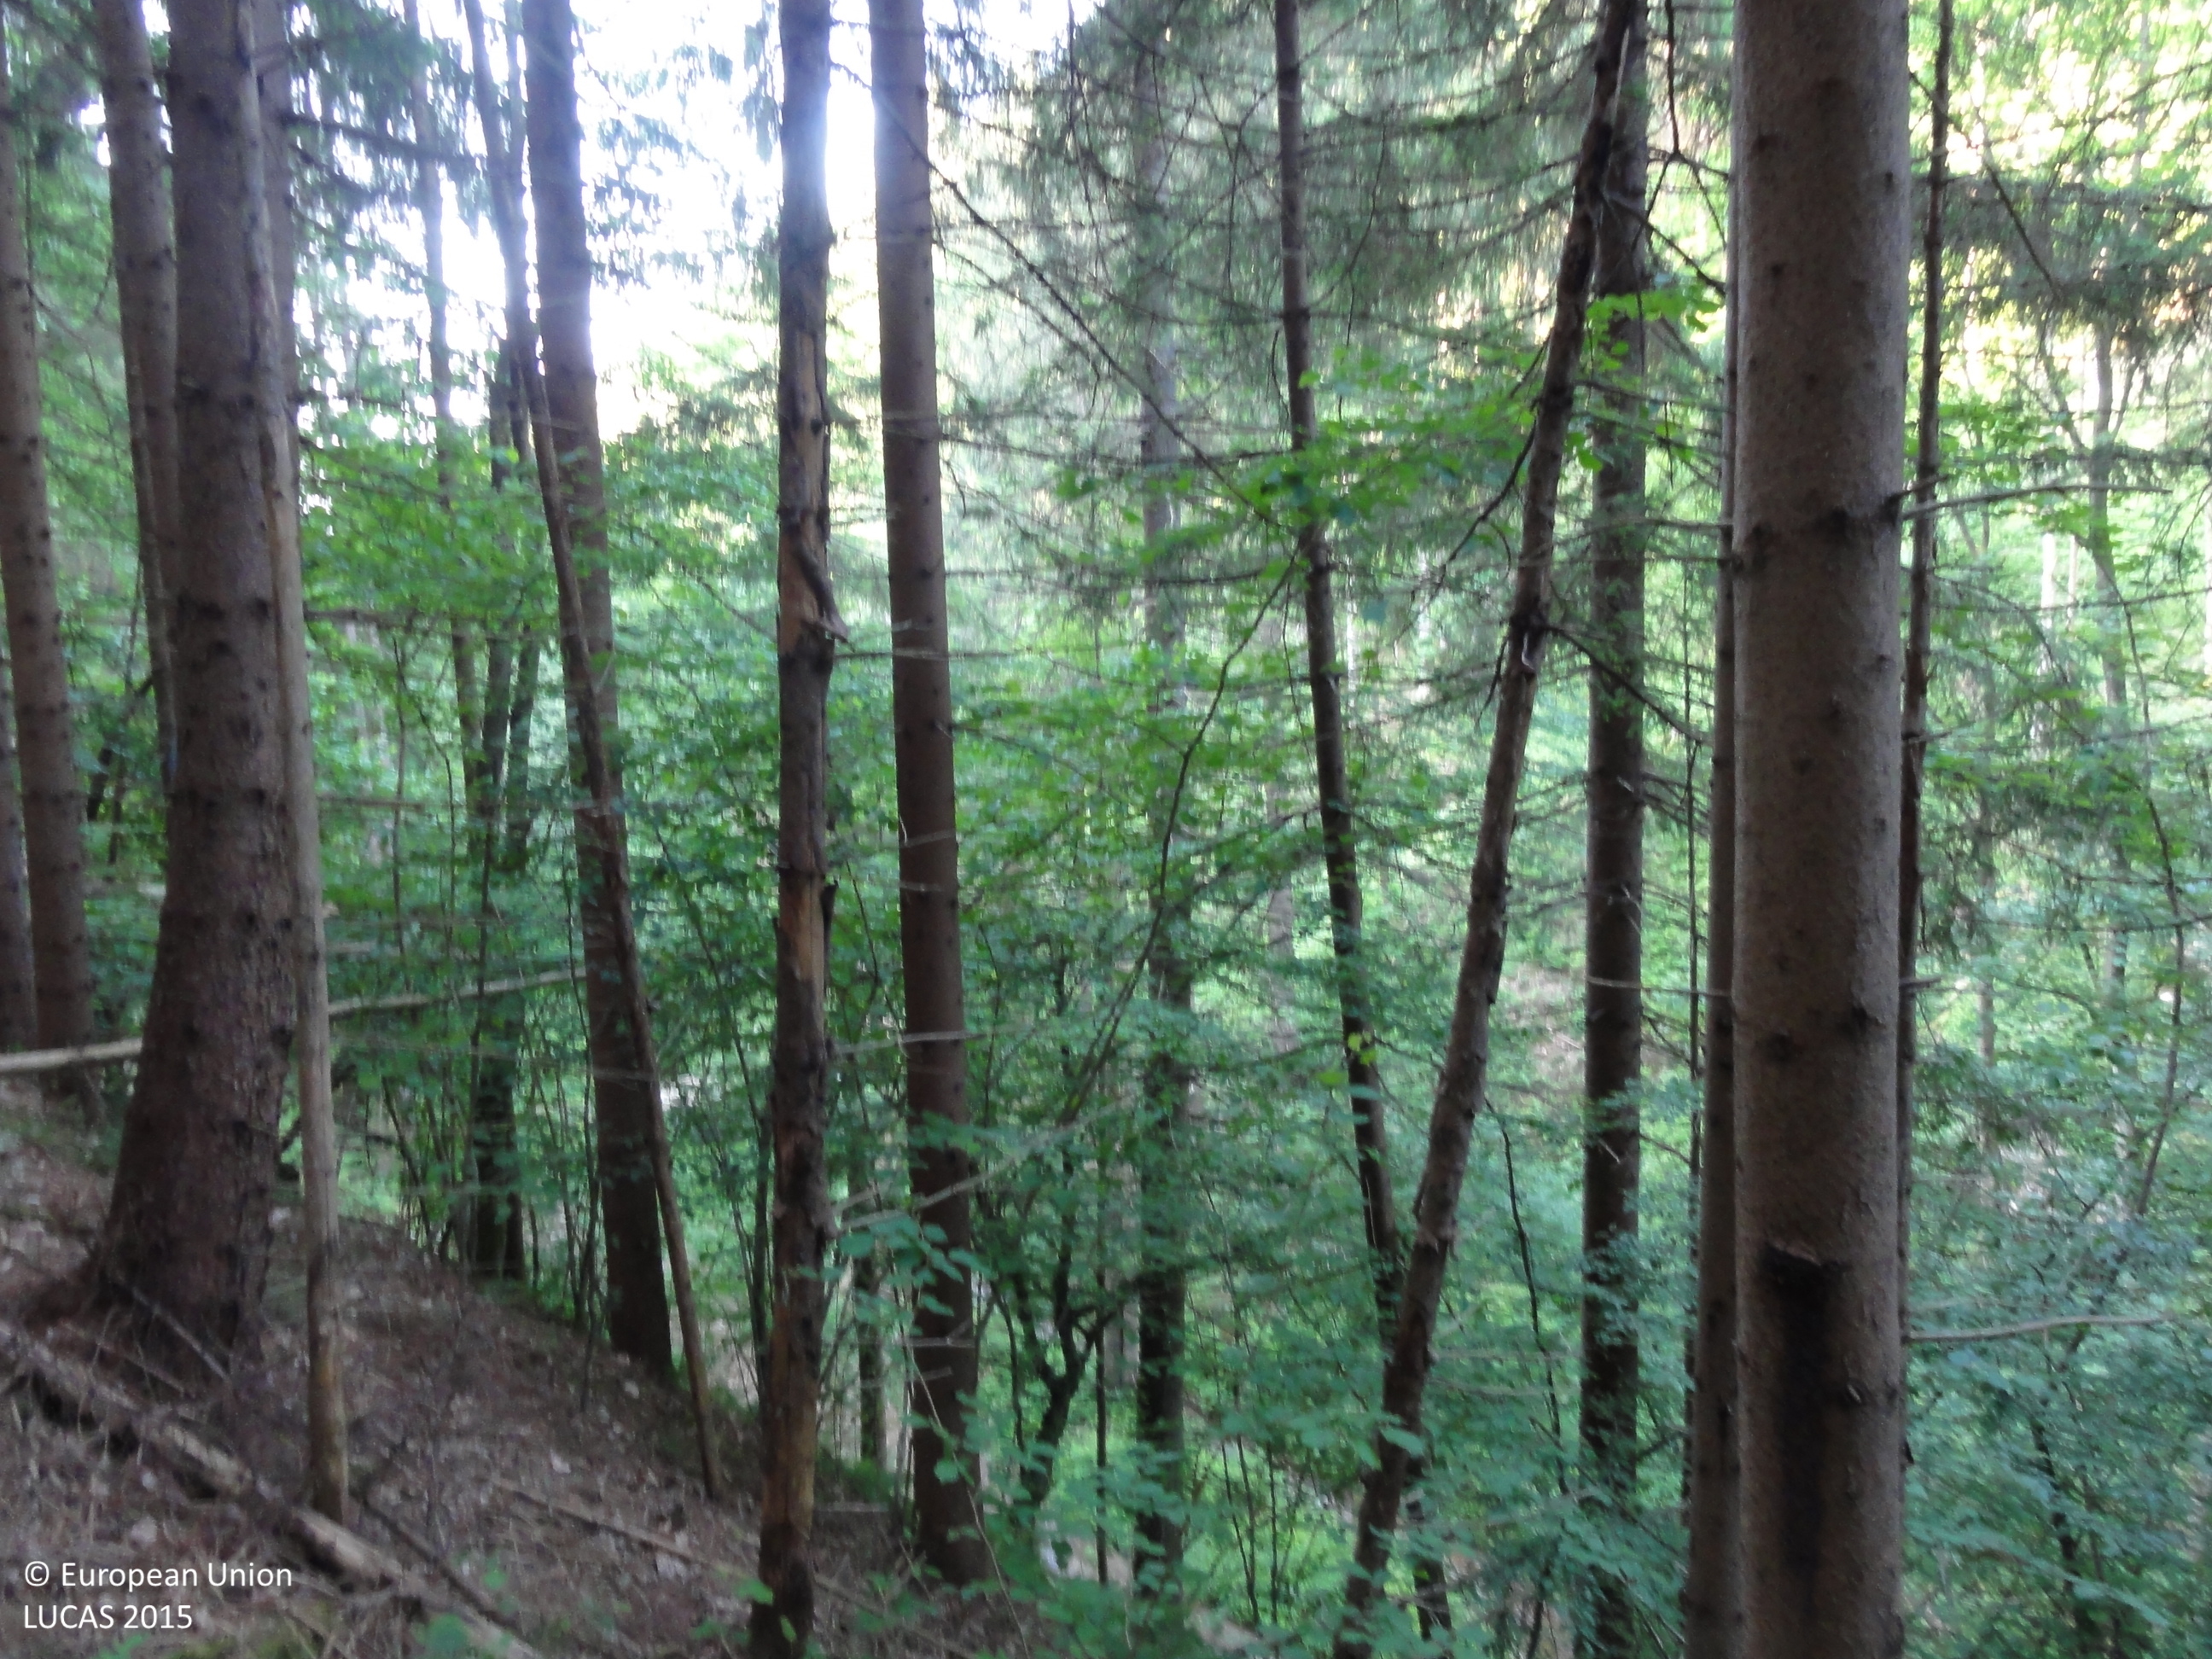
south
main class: Woodland
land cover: Spruce dominated mixed woodland
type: alpine coniferous forest
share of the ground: > 75 %
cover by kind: coniferous forest trees 60 %, broadleaved forest trees 35 %, shrubs 5 %
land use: Forestry
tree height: > 5 m
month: June
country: SI
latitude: 46.5810
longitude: 14.9177
